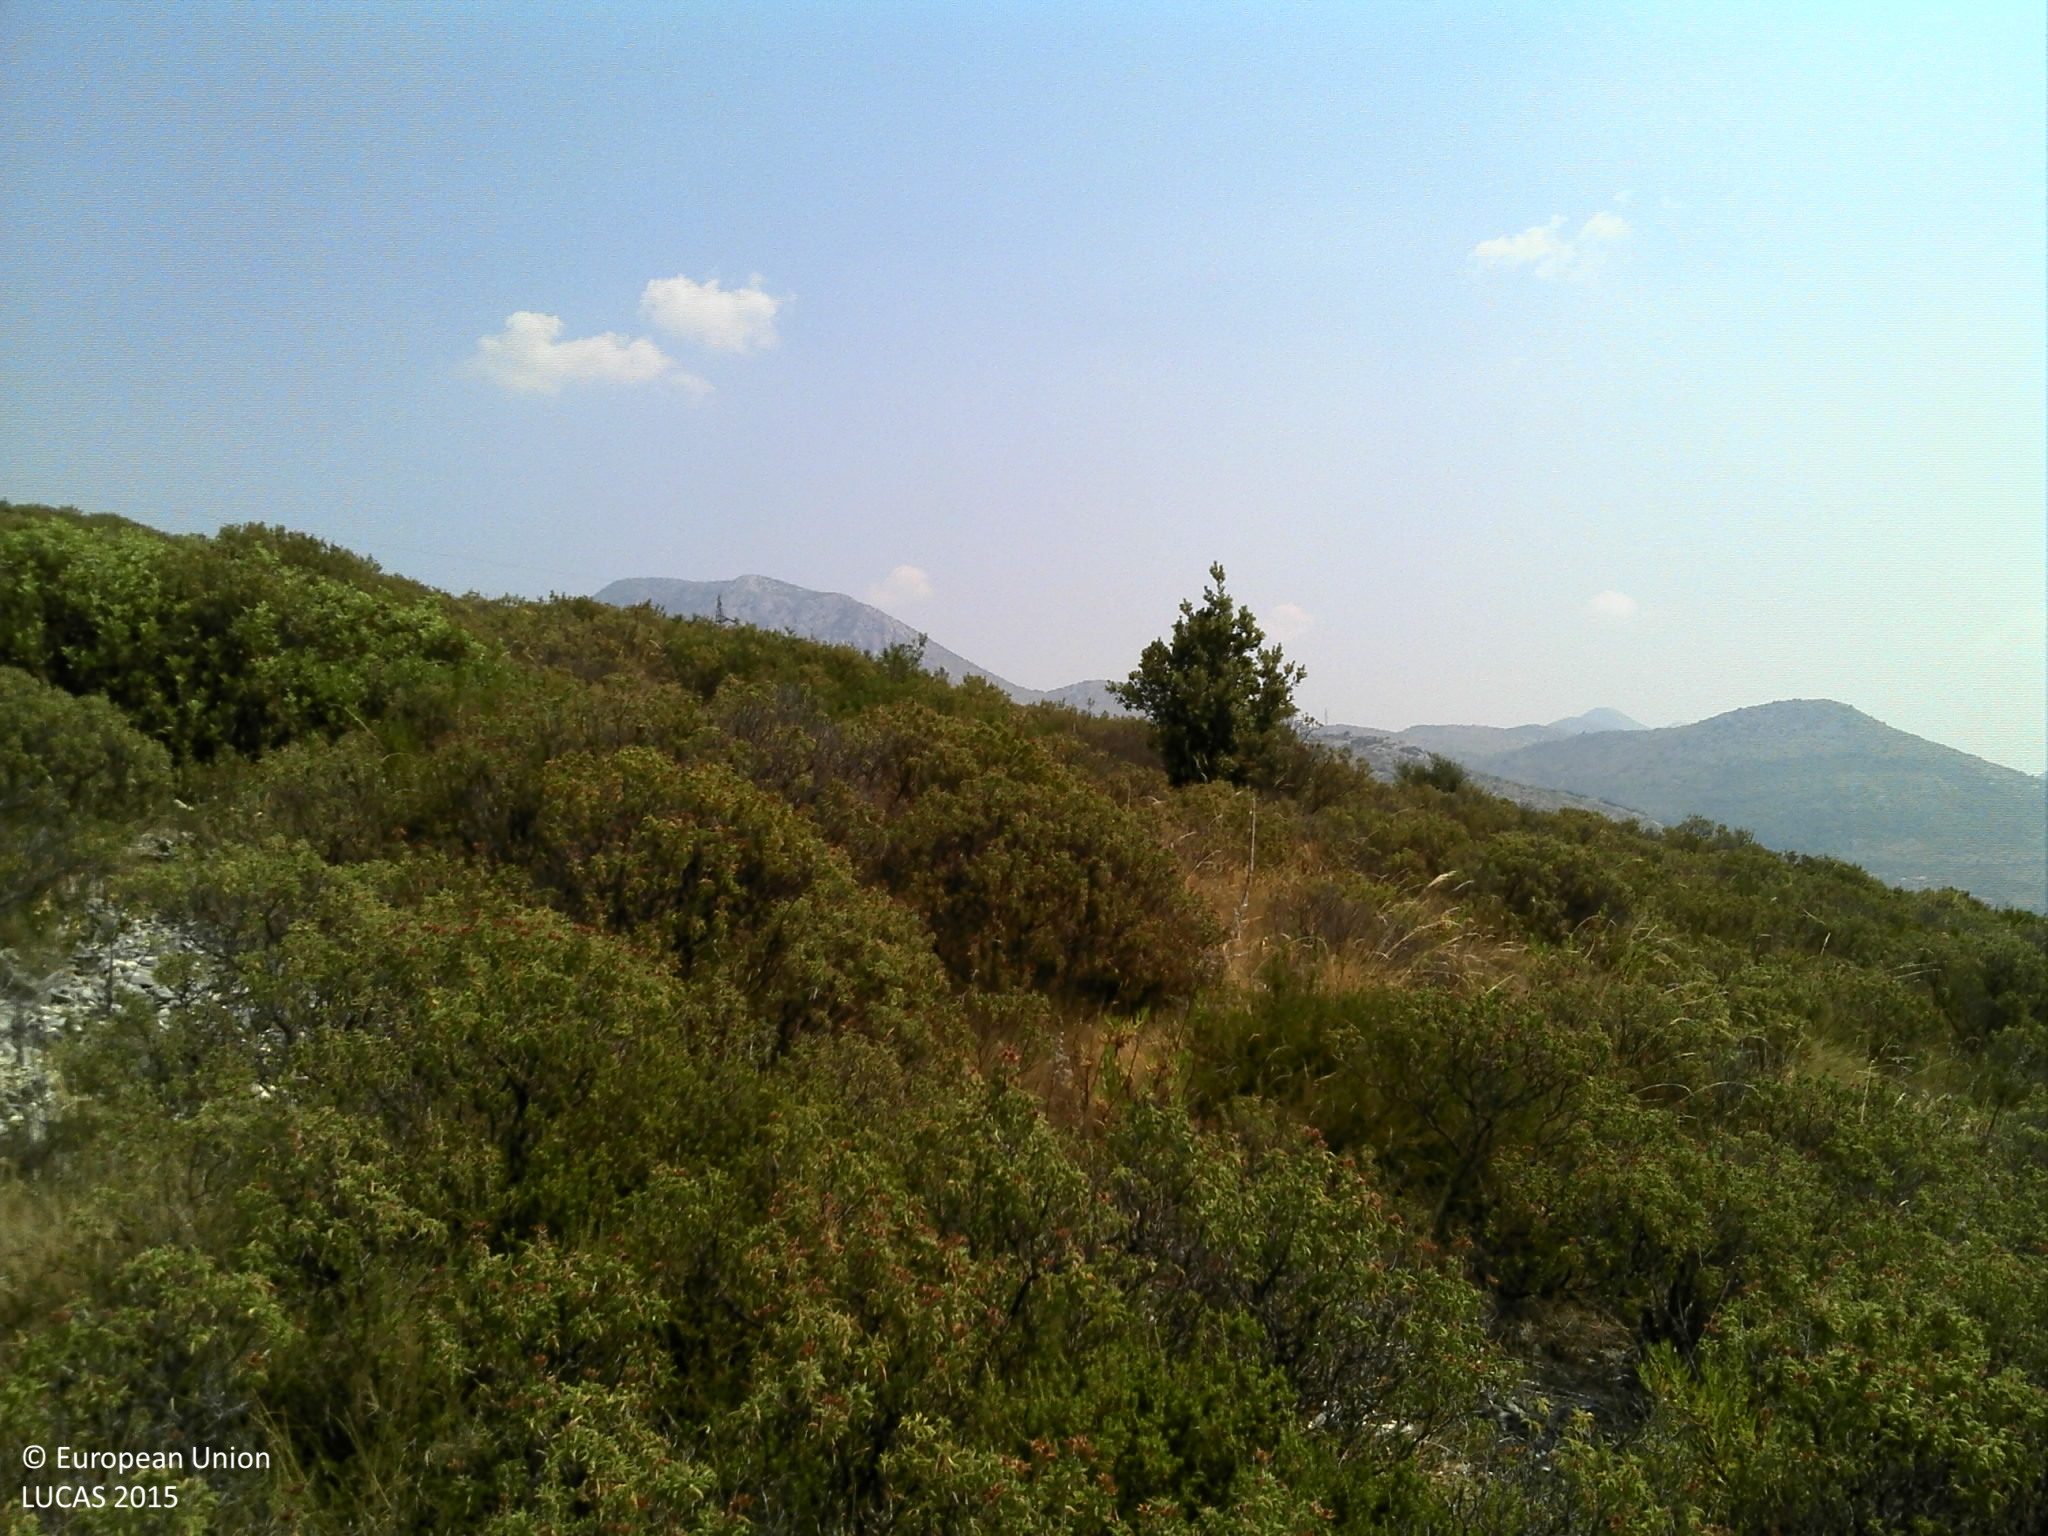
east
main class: Shrubland
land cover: Shrubland without tree cover
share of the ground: 50 - 75 %
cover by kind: shrubs 50 %, herbaceous plants 25 %, consolidated bare surface 25 %
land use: Semi-natural and natural areas not in use
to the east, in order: Shrubland without tree cover
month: July
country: HR
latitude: 42.8041
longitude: 17.8284
